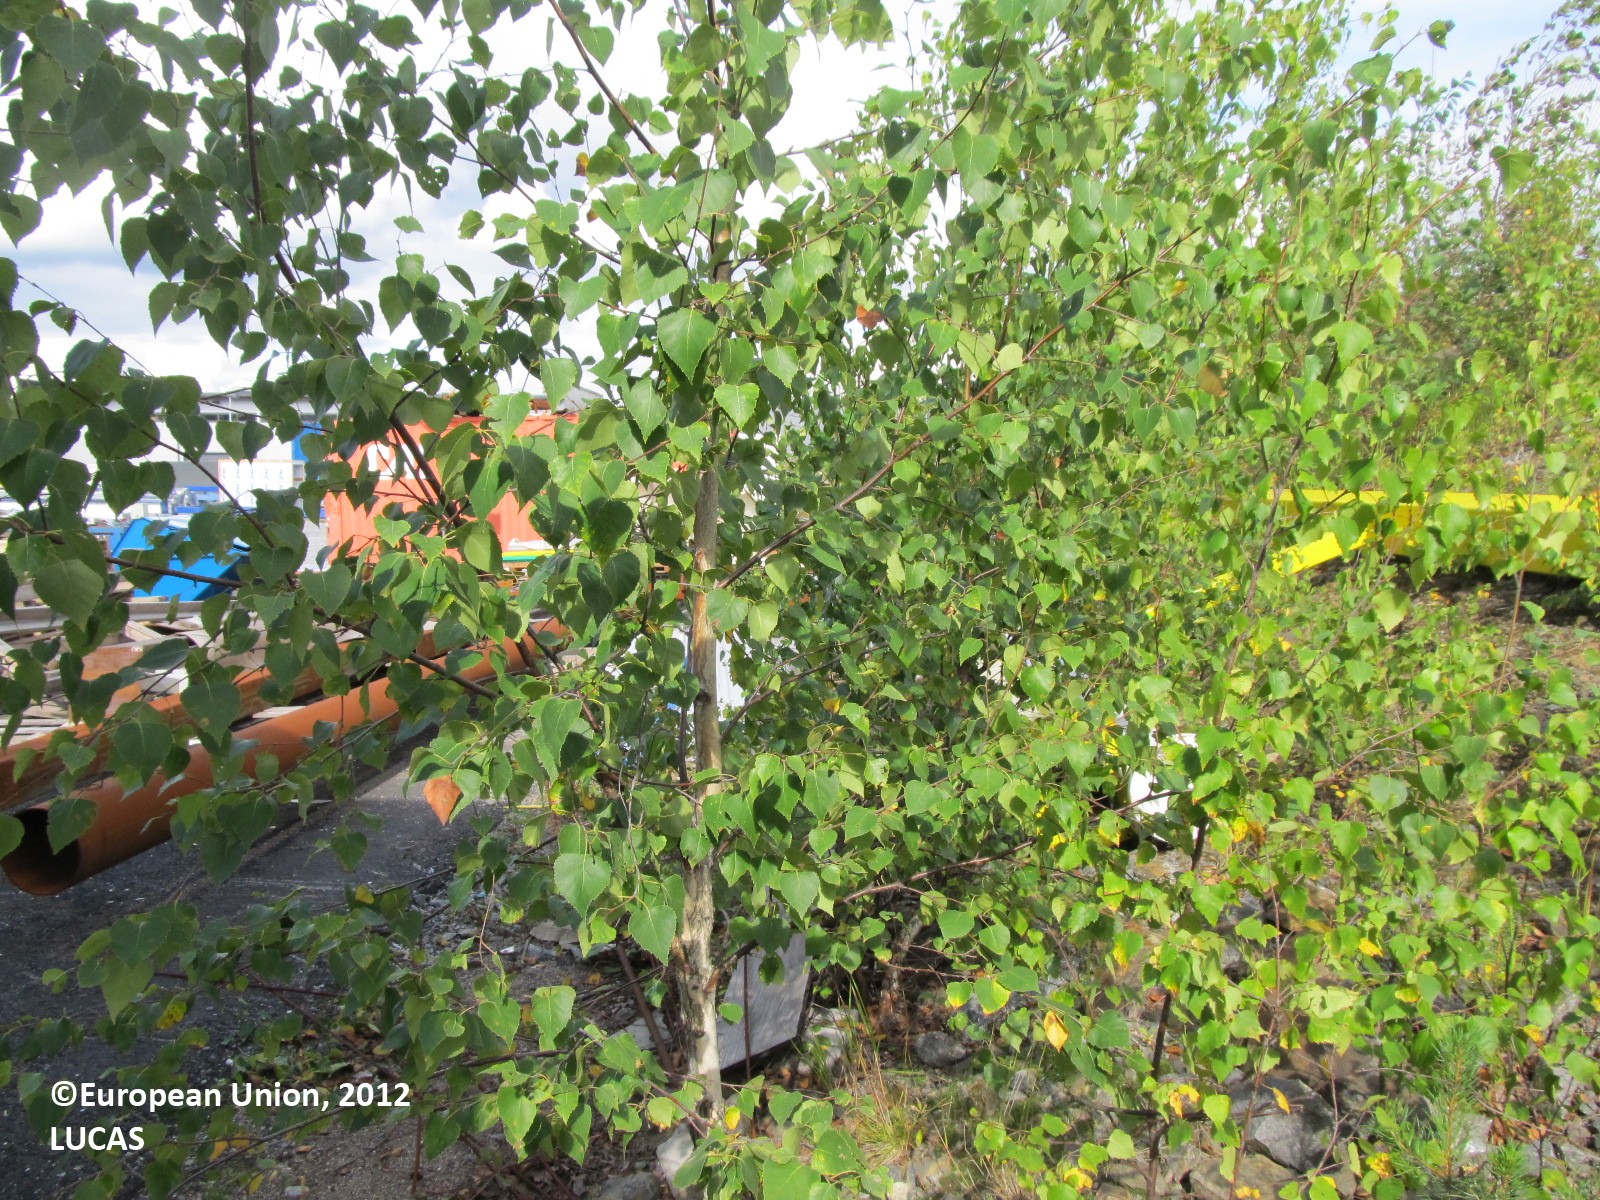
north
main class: Woodland
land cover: Pine dominated mixed woodland
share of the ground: 25 - 50 %
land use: Commerce, finance, business
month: August
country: FI
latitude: 62.9623
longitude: 27.6980
